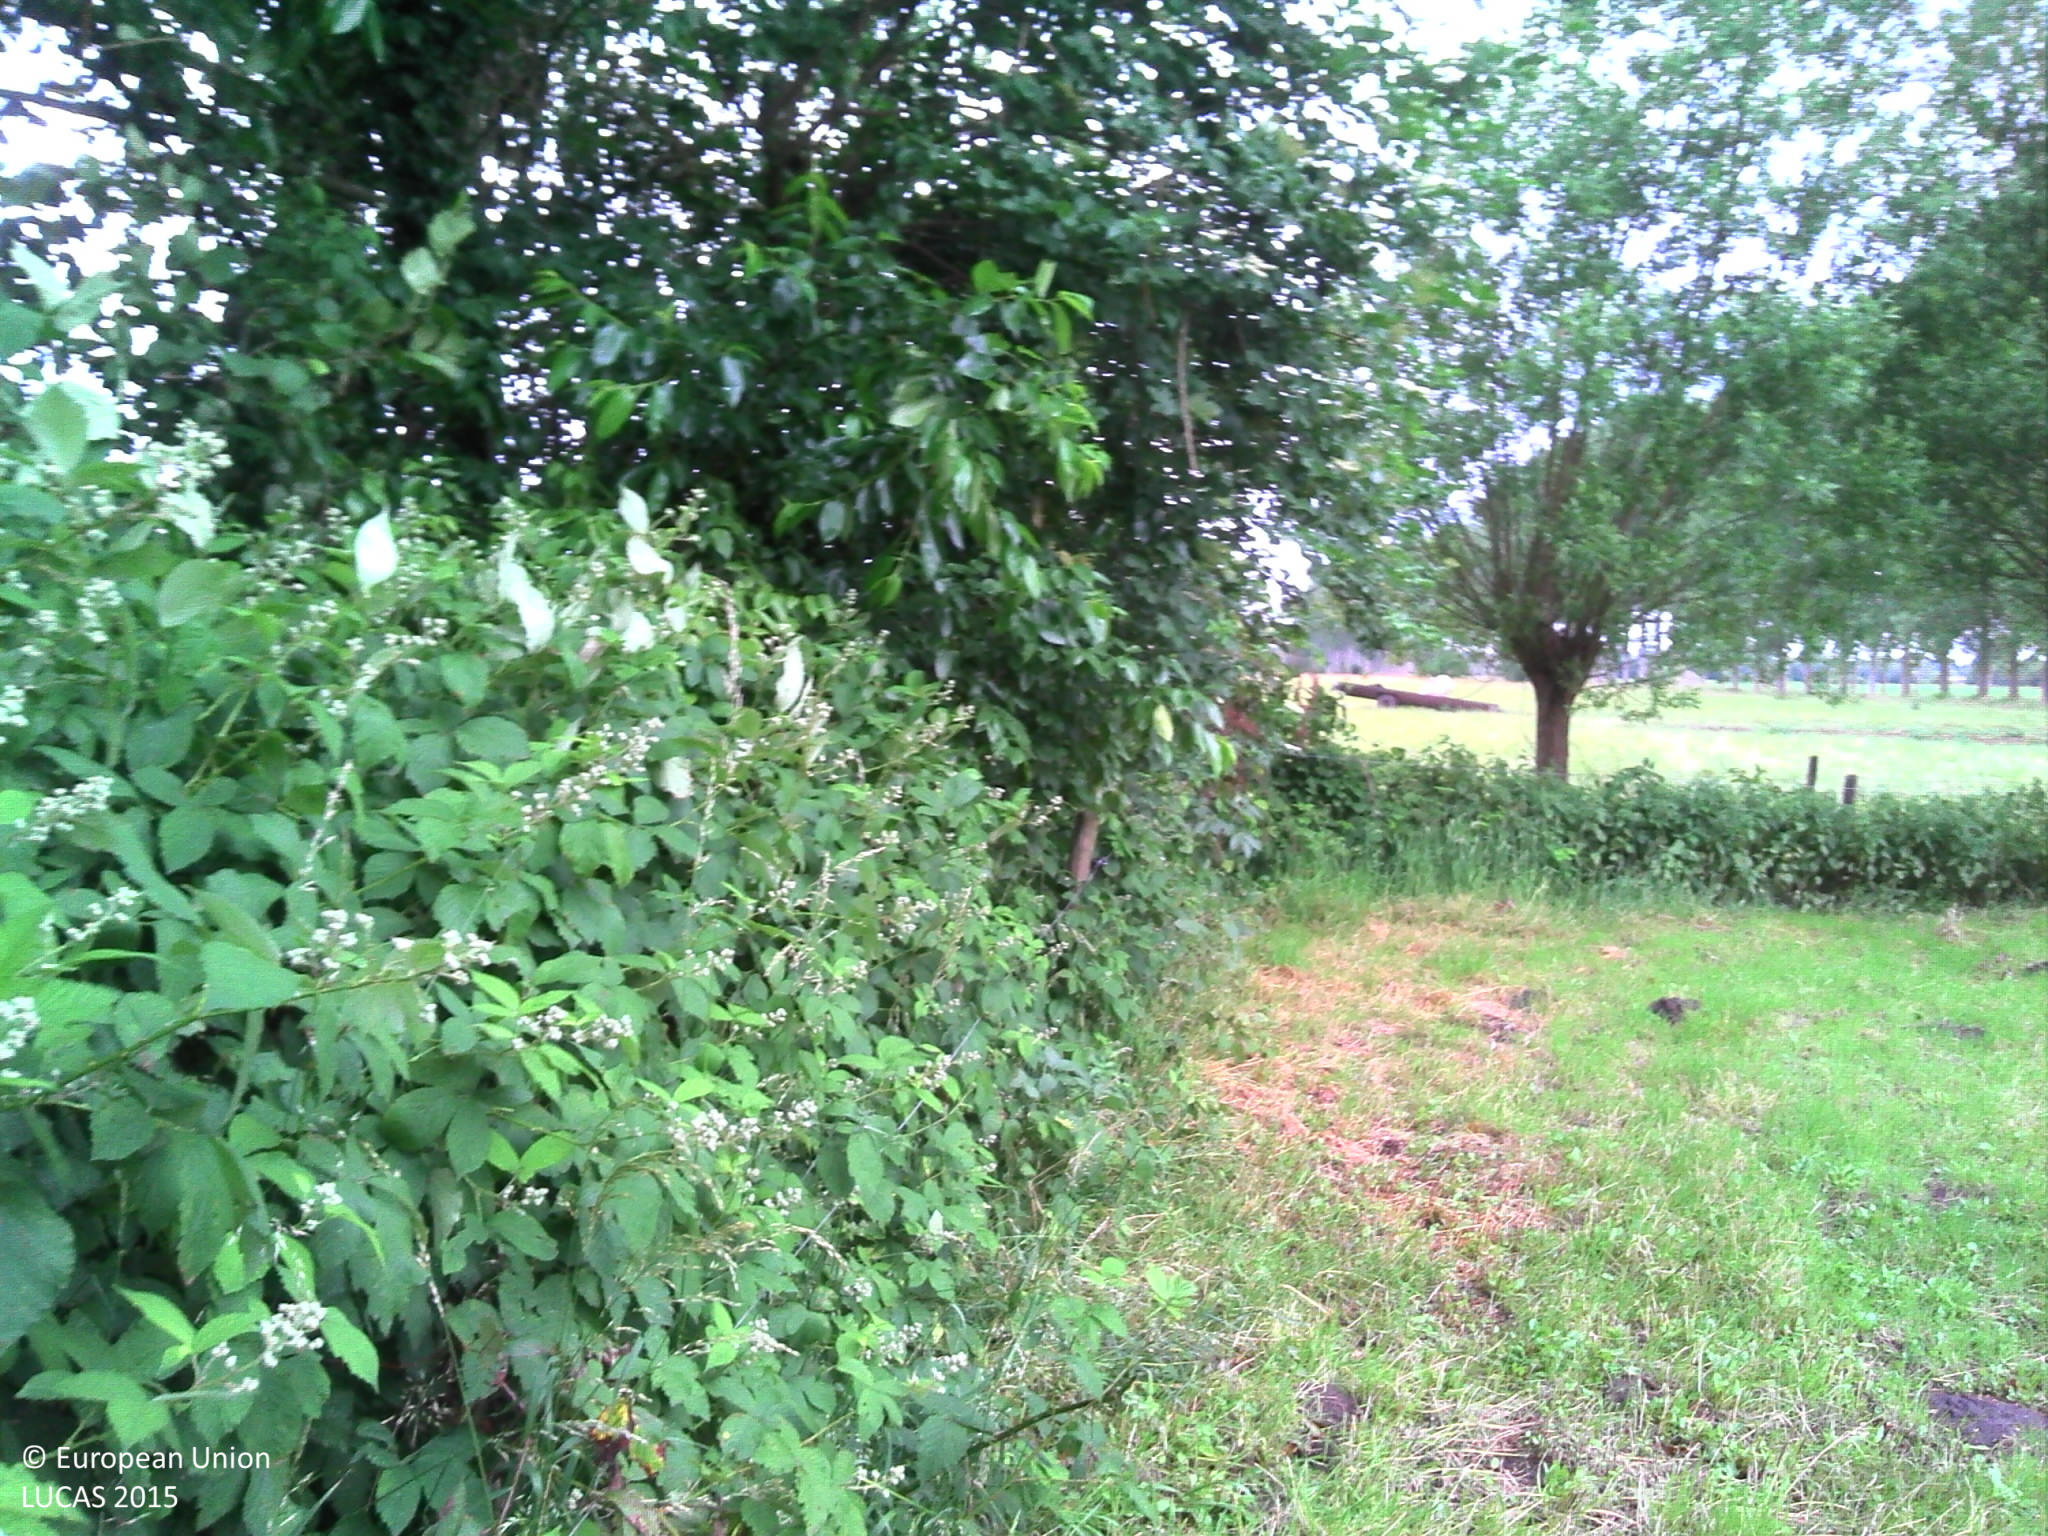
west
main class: Woodland
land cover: Broadleaved woodland
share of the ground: > 75 %
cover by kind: broadleaved forest trees 100 %
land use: Residential
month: June
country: BE
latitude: 51.1787
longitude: 3.9717
